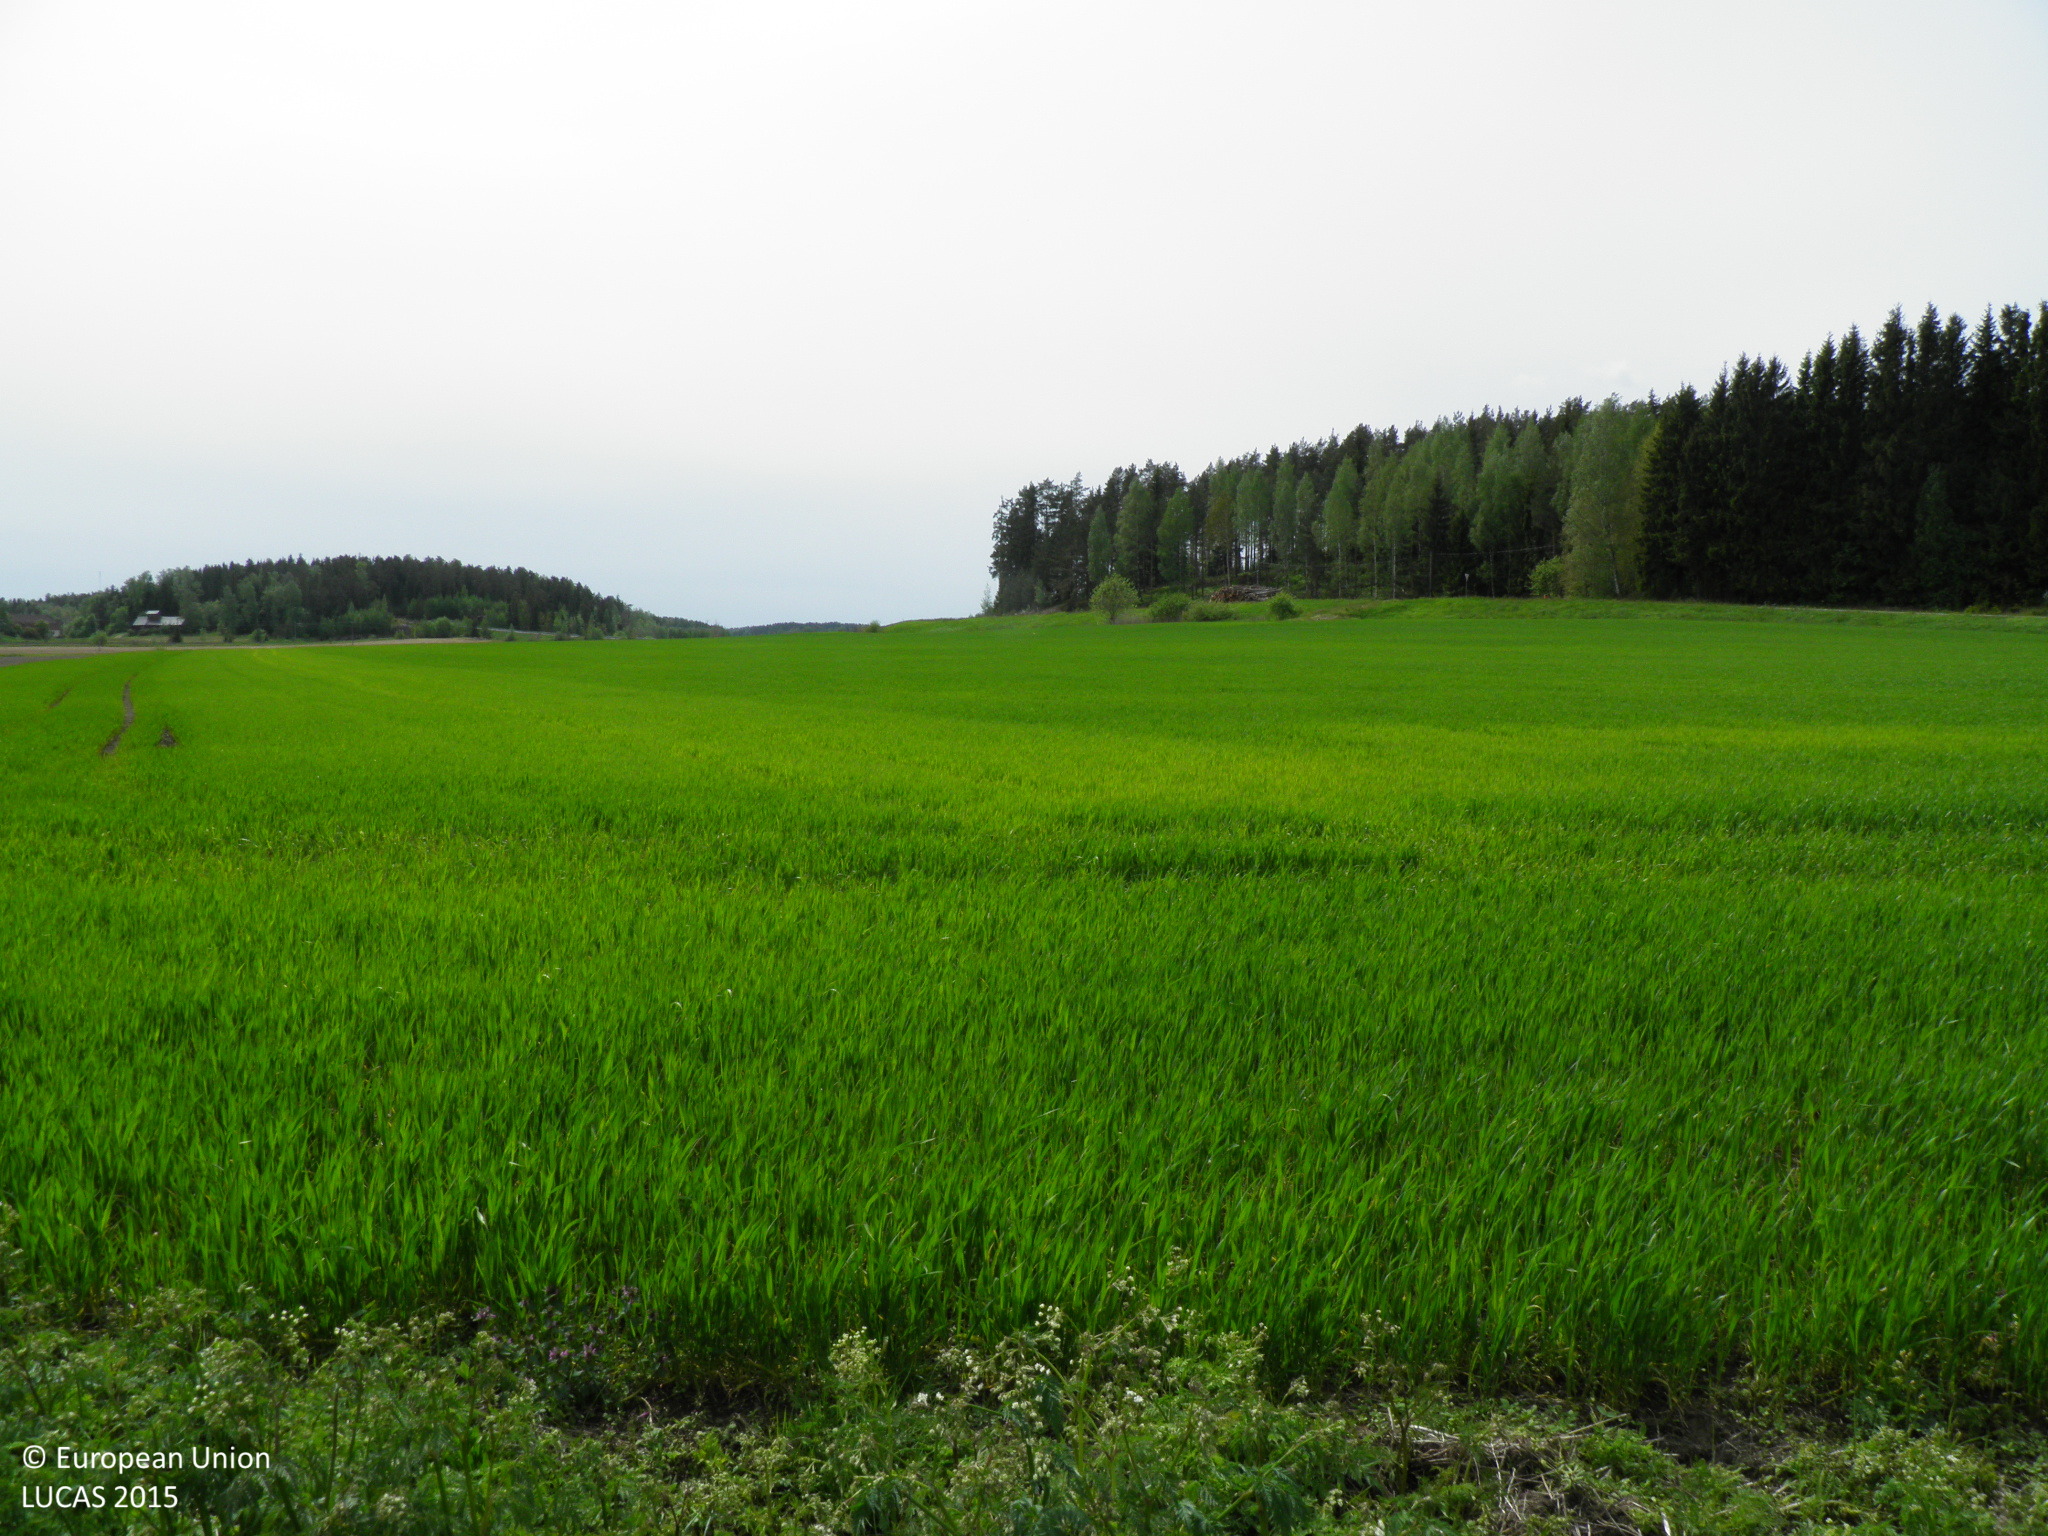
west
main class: Cropland
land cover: Common wheat
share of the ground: > 75 %
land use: Agriculture (excluding fallow land and kitchen gardens)
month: June
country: FI
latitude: 60.4678
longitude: 22.6401
